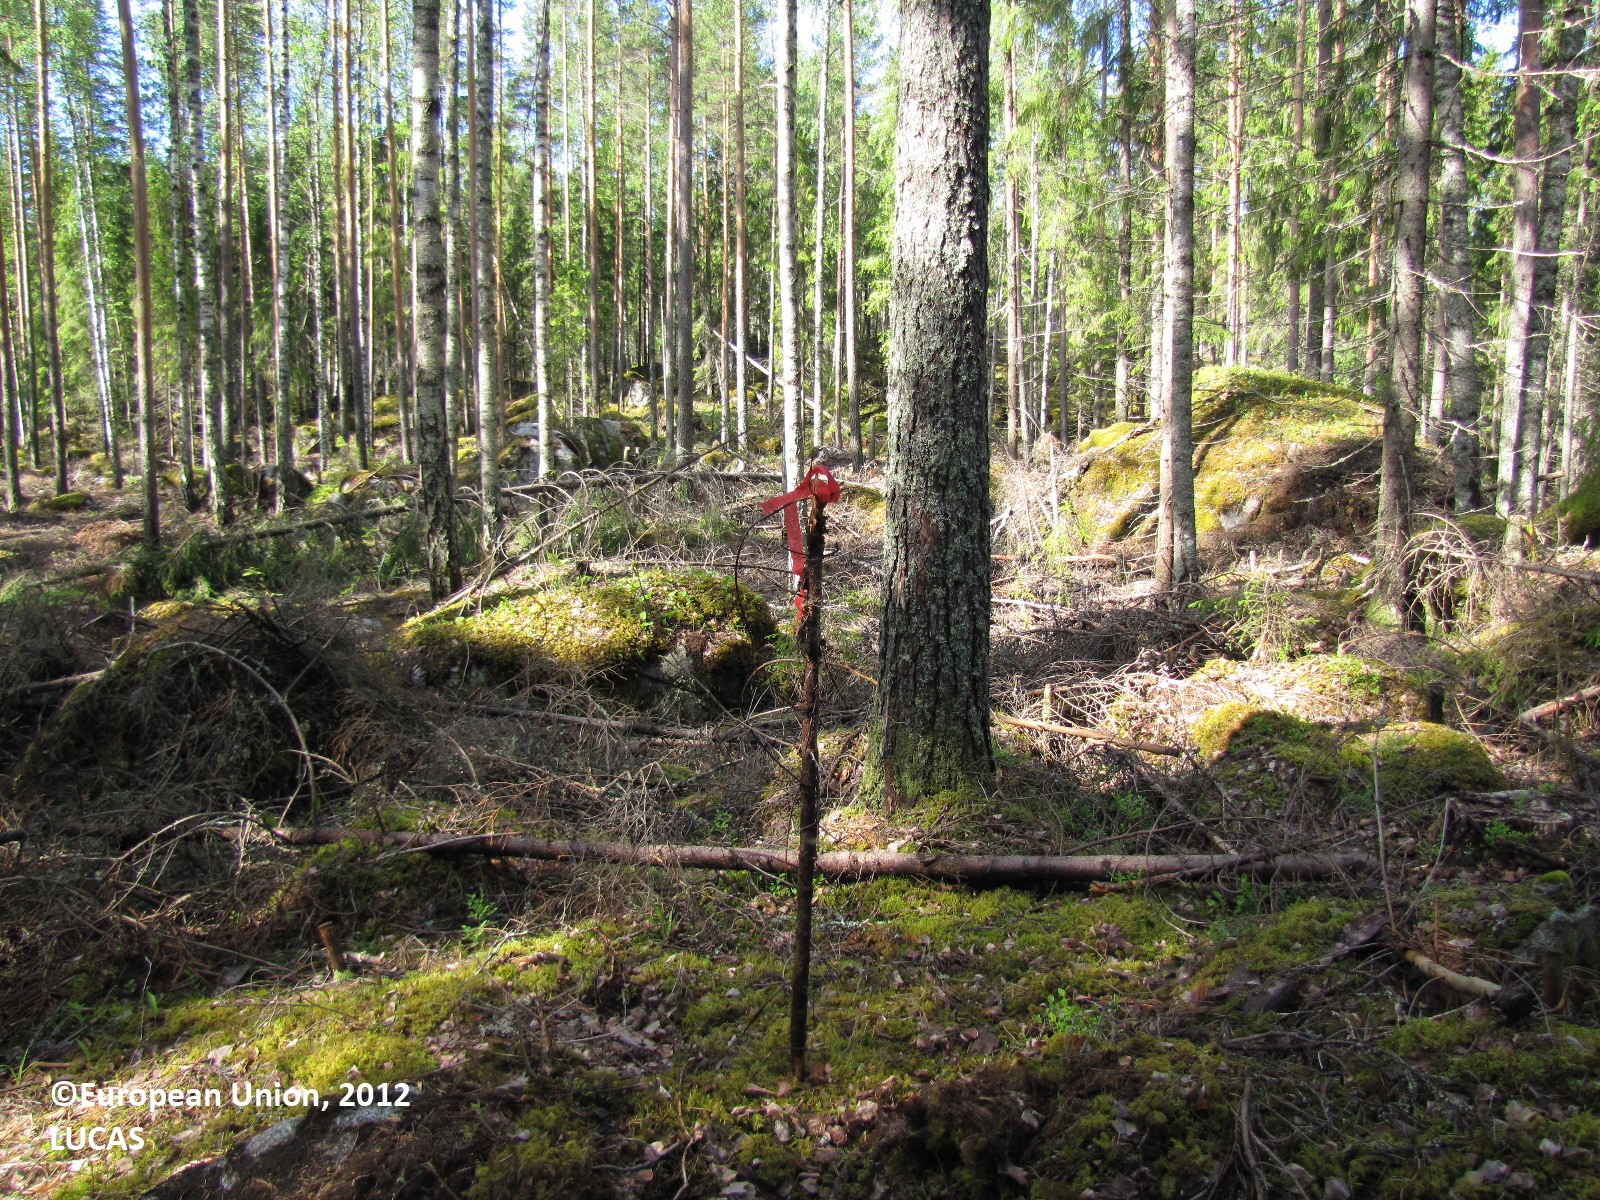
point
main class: Woodland
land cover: Pine dominated mixed woodland
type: boreal forest
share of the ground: 50 - 75 %
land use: Forestry
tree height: > 5 m
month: June
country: FI
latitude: 61.3936
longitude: 24.6502
